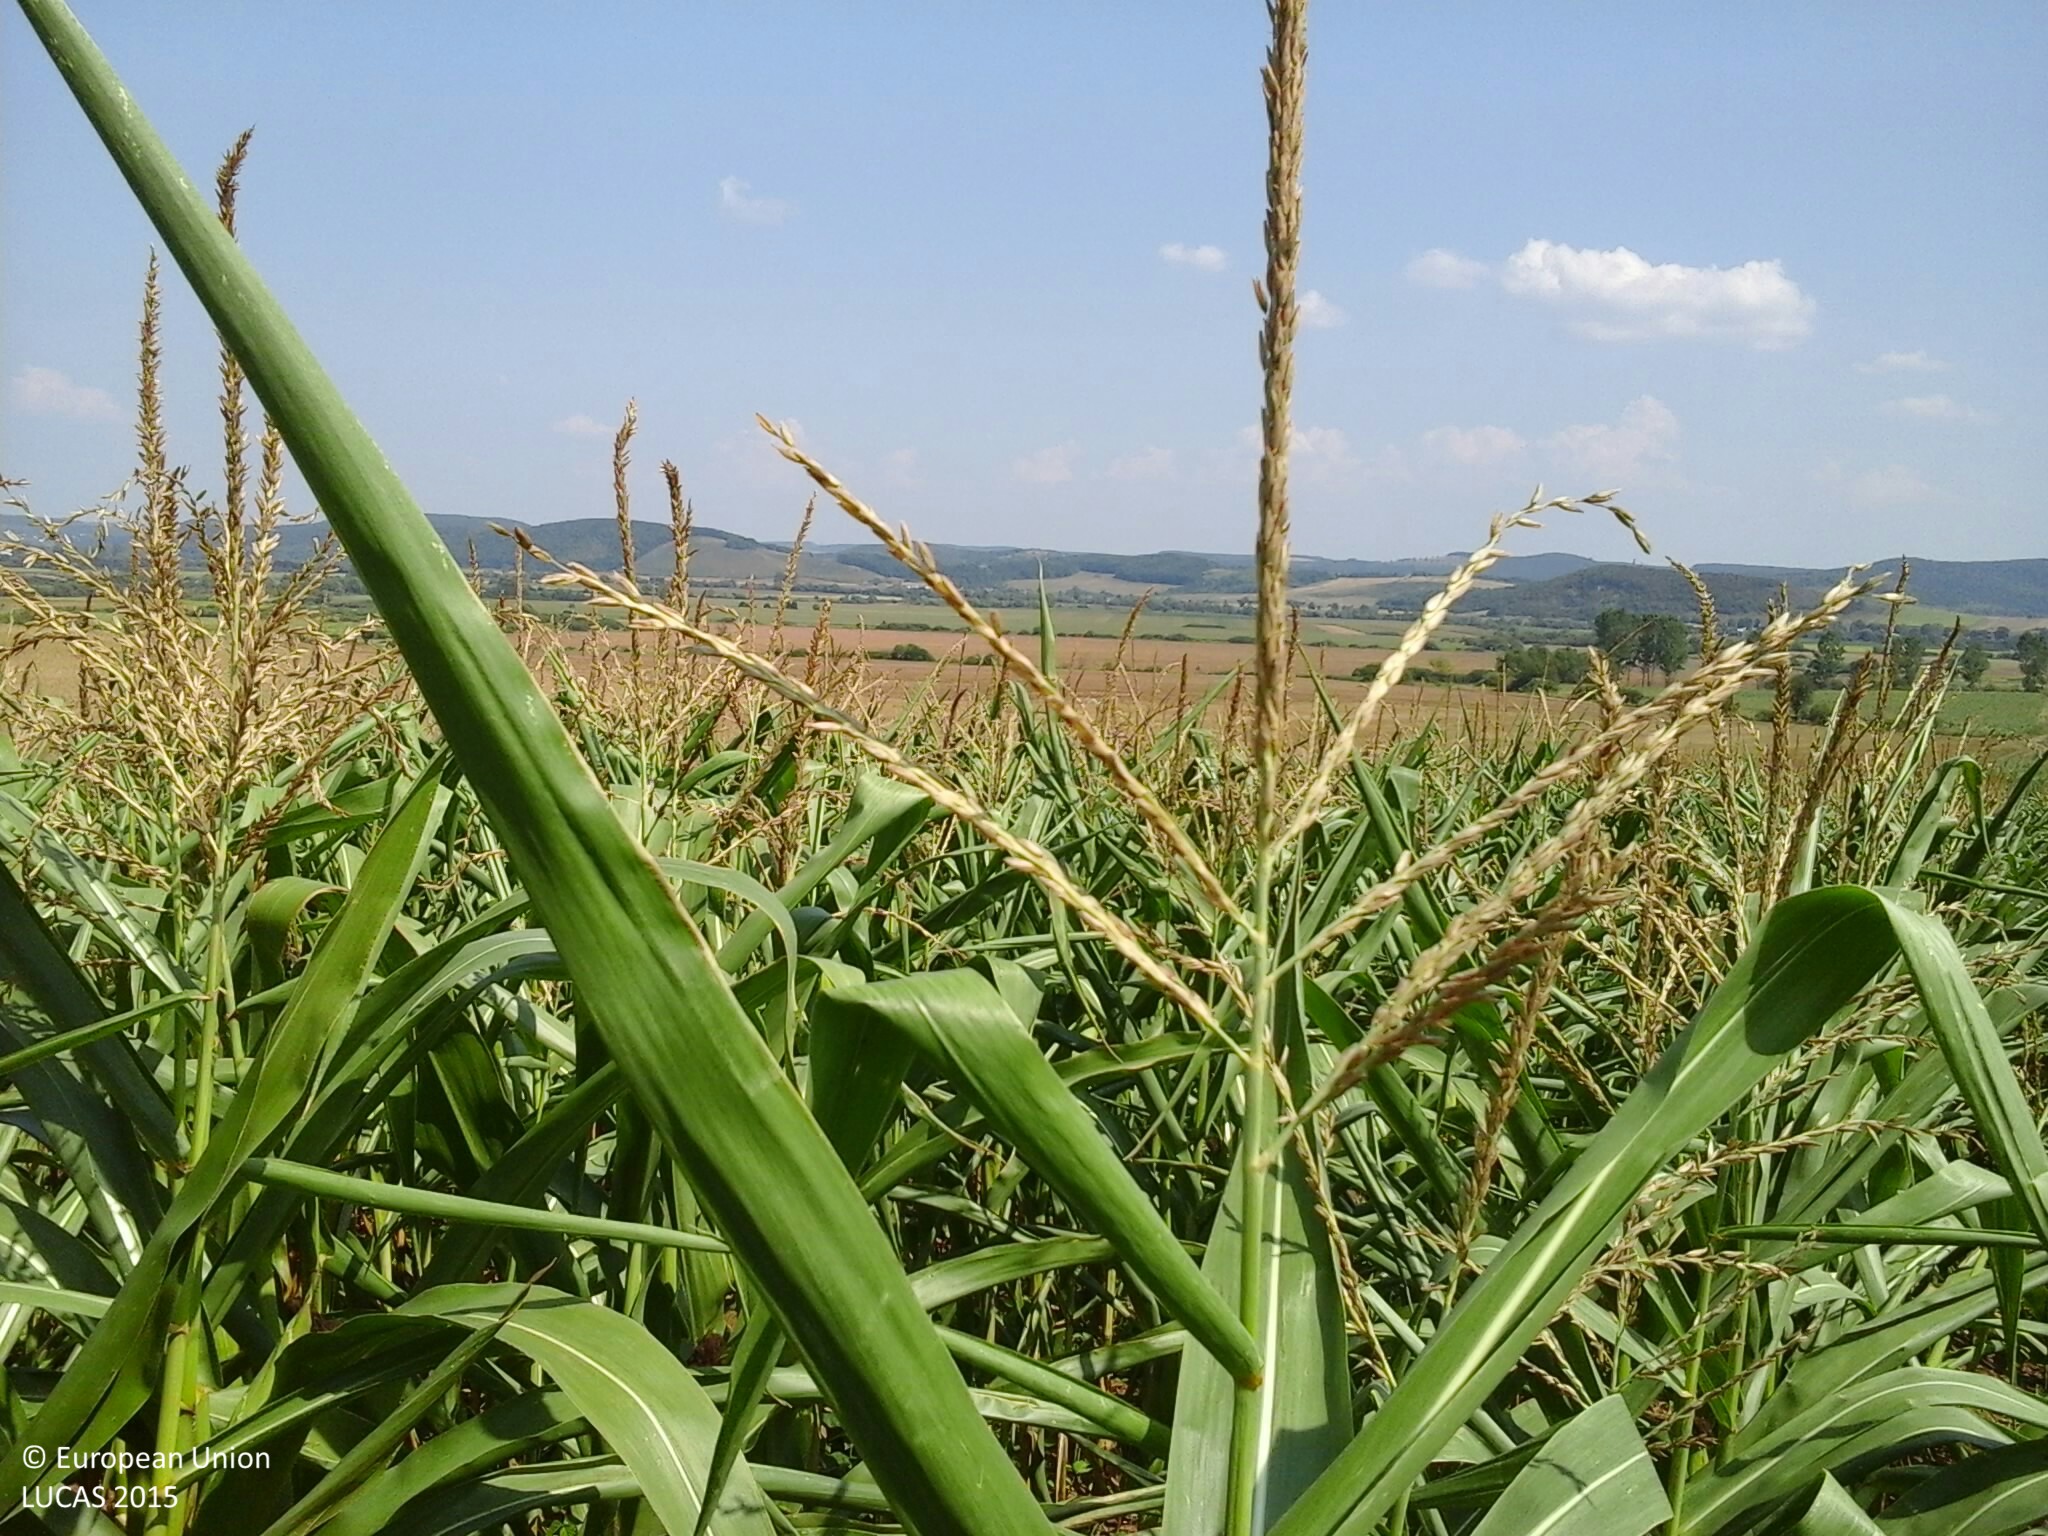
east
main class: Cropland
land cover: Maize
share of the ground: > 75 %
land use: Agriculture (excluding fallow land and kitchen gardens)
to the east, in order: Maize; Ditches and canals; Tracks; Grass margins; Common wheat
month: August
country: HU
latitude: 48.4272
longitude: 20.6997
